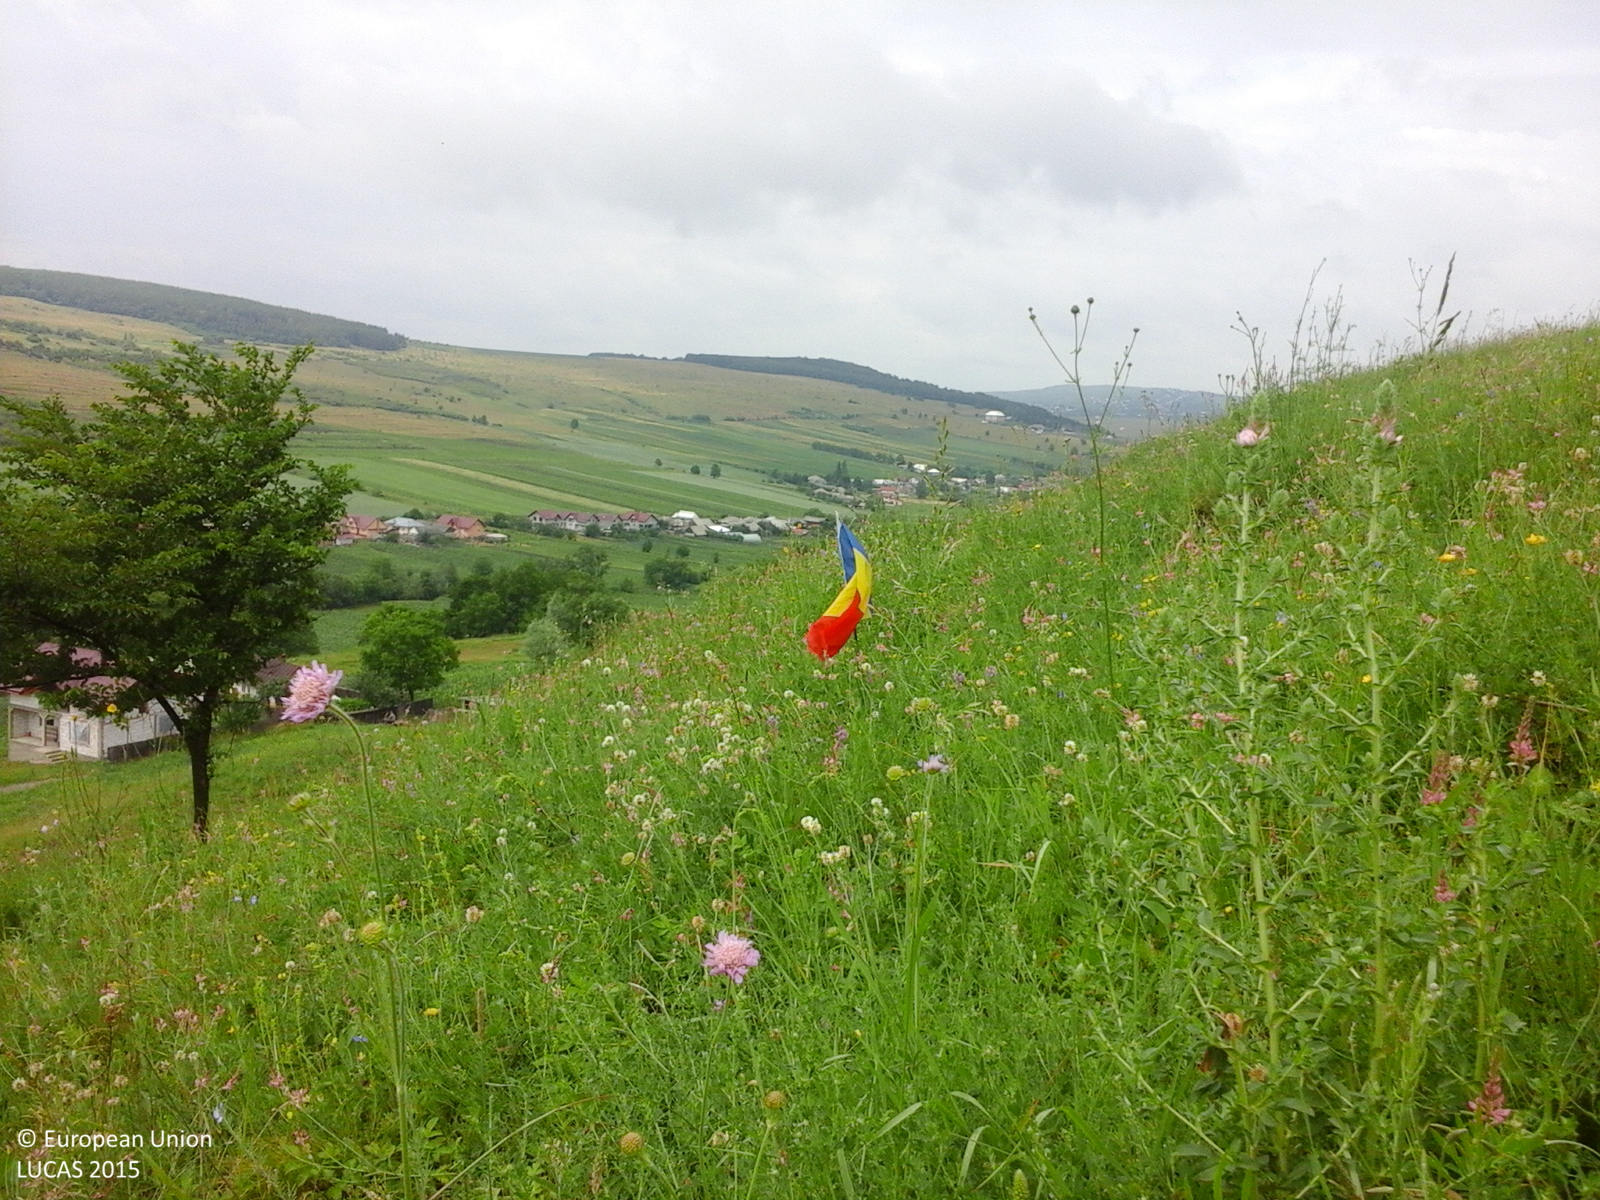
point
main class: Grassland
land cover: Grassland without tree/shrub cover
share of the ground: > 75 %
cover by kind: herbaceous plants 100 %
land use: Agriculture (excluding fallow land and kitchen gardens)
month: June
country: RO
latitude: 47.4281
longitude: 26.3782
